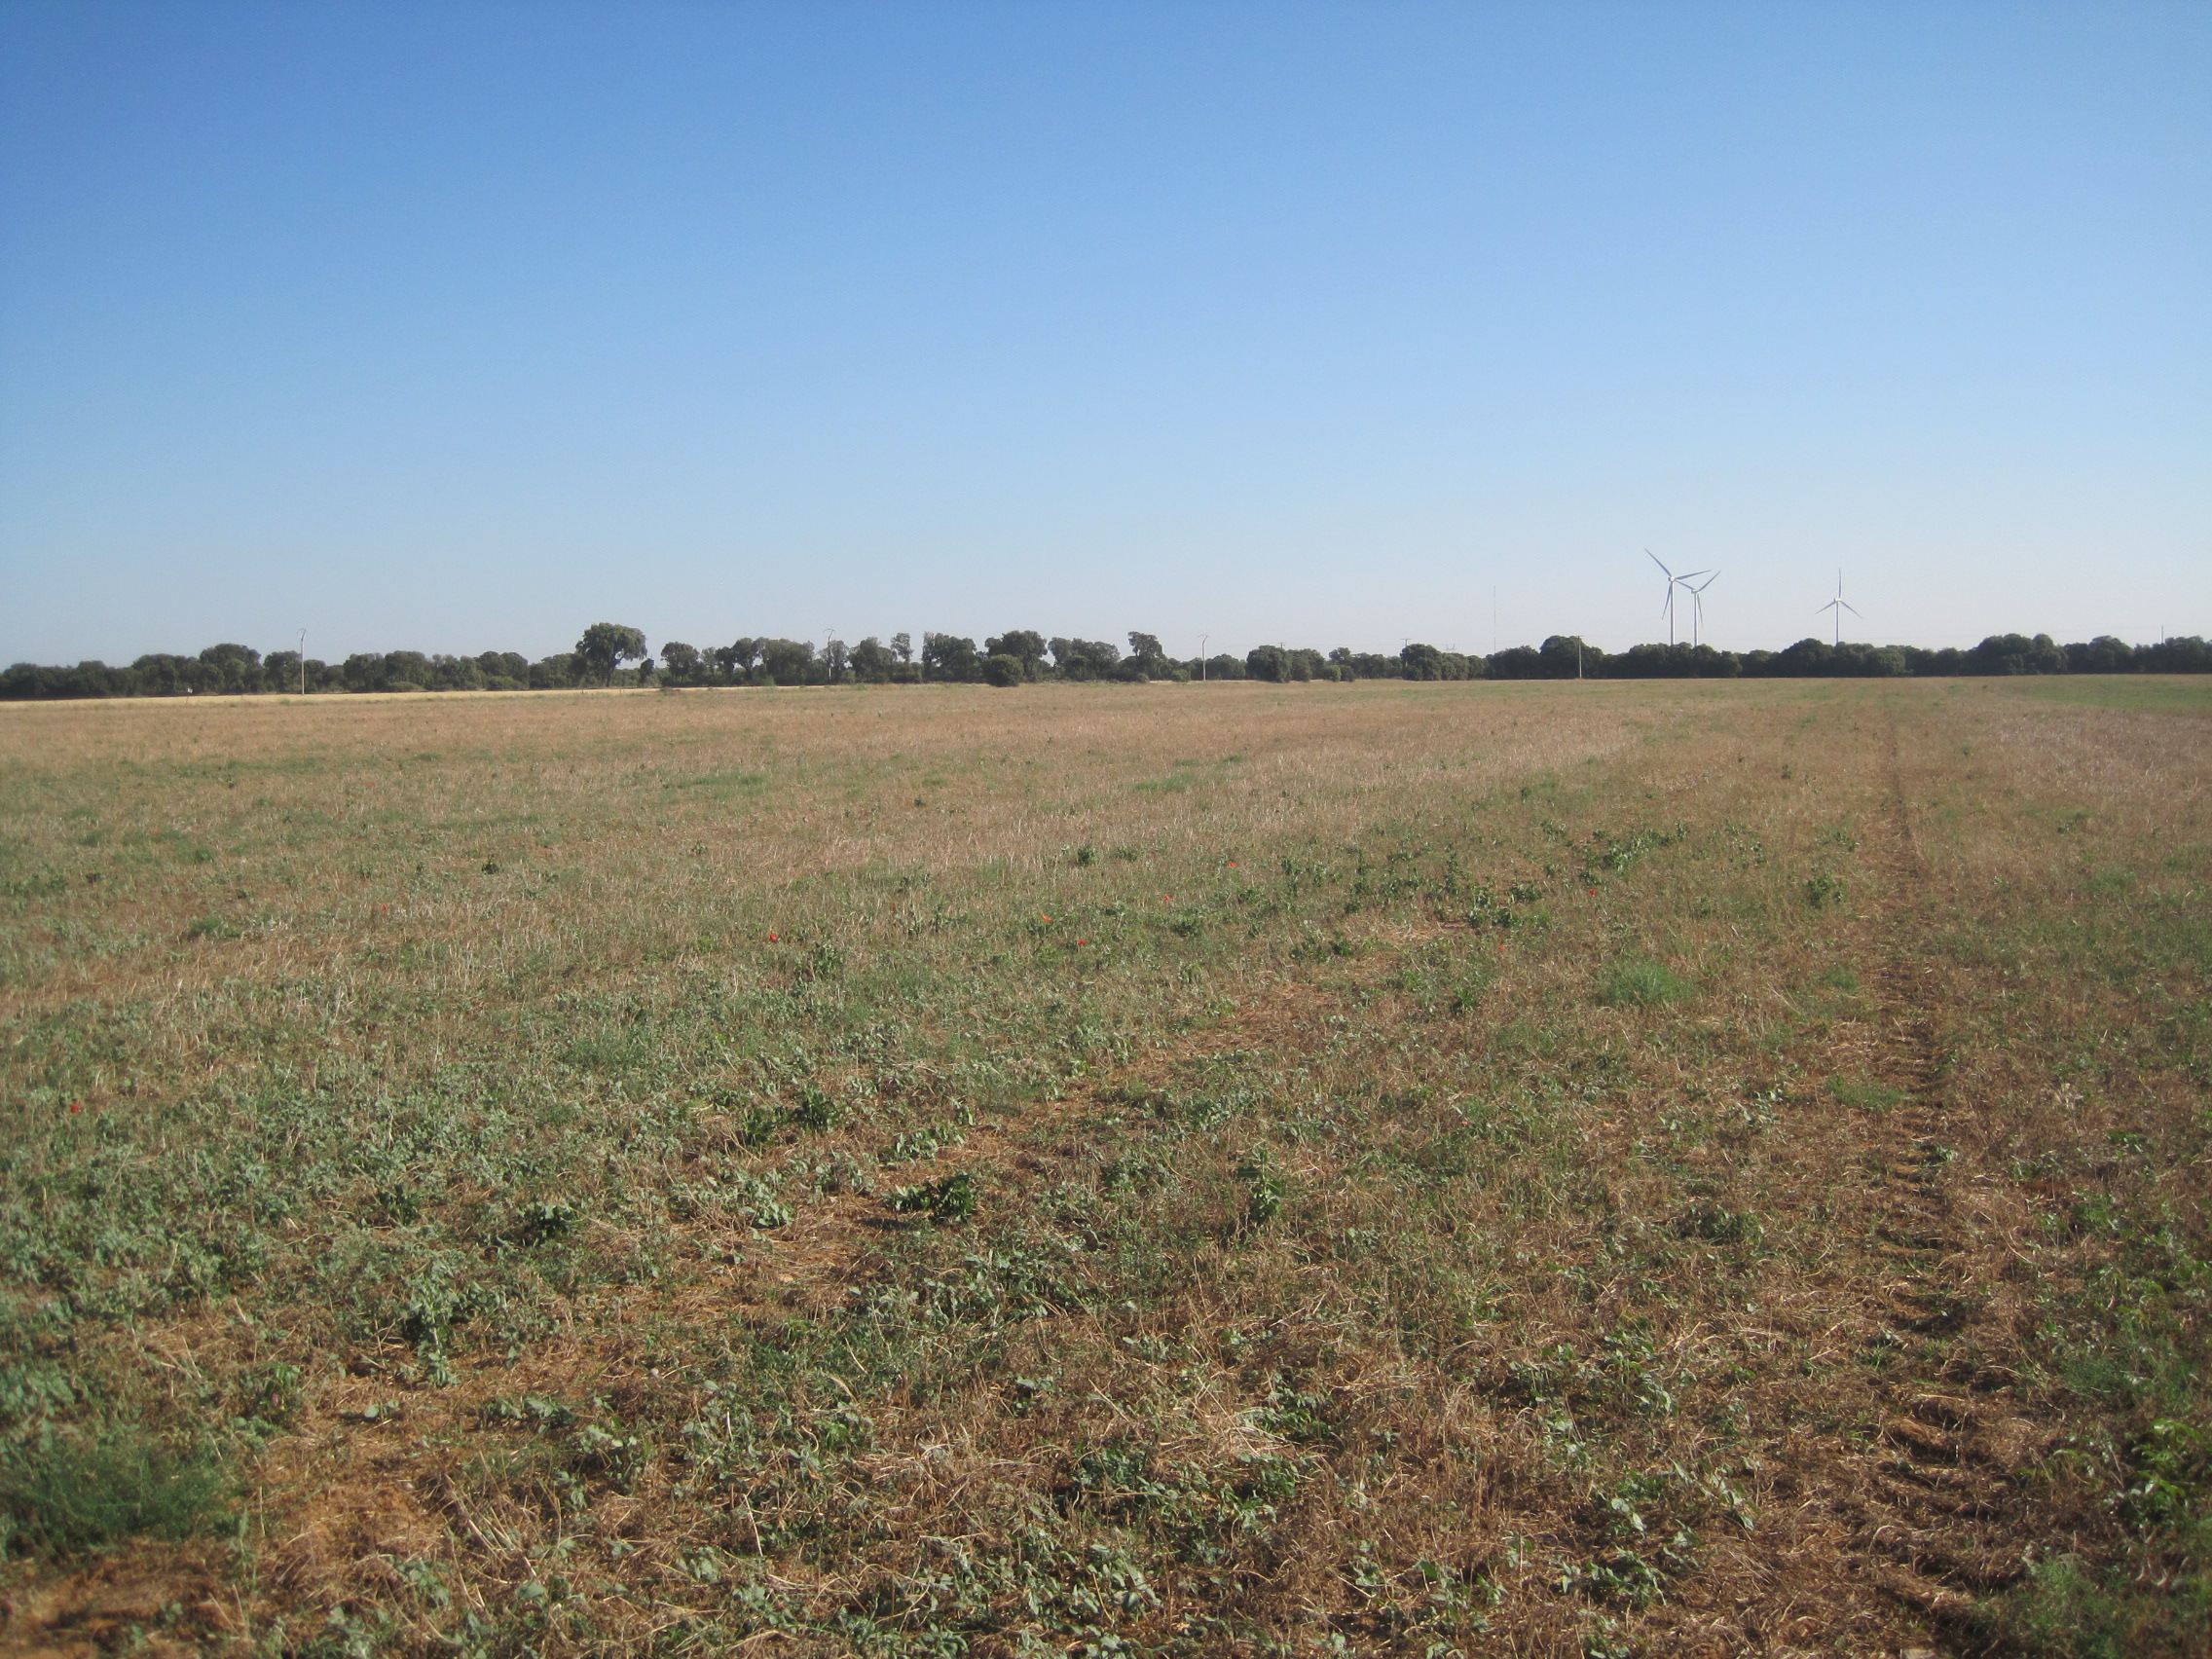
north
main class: Cropland
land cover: Dry pulses
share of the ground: < 10 %
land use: Agriculture (excluding fallow land and kitchen gardens)
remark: Harvested field
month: July
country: ES
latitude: 41.8490
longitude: -4.8277
